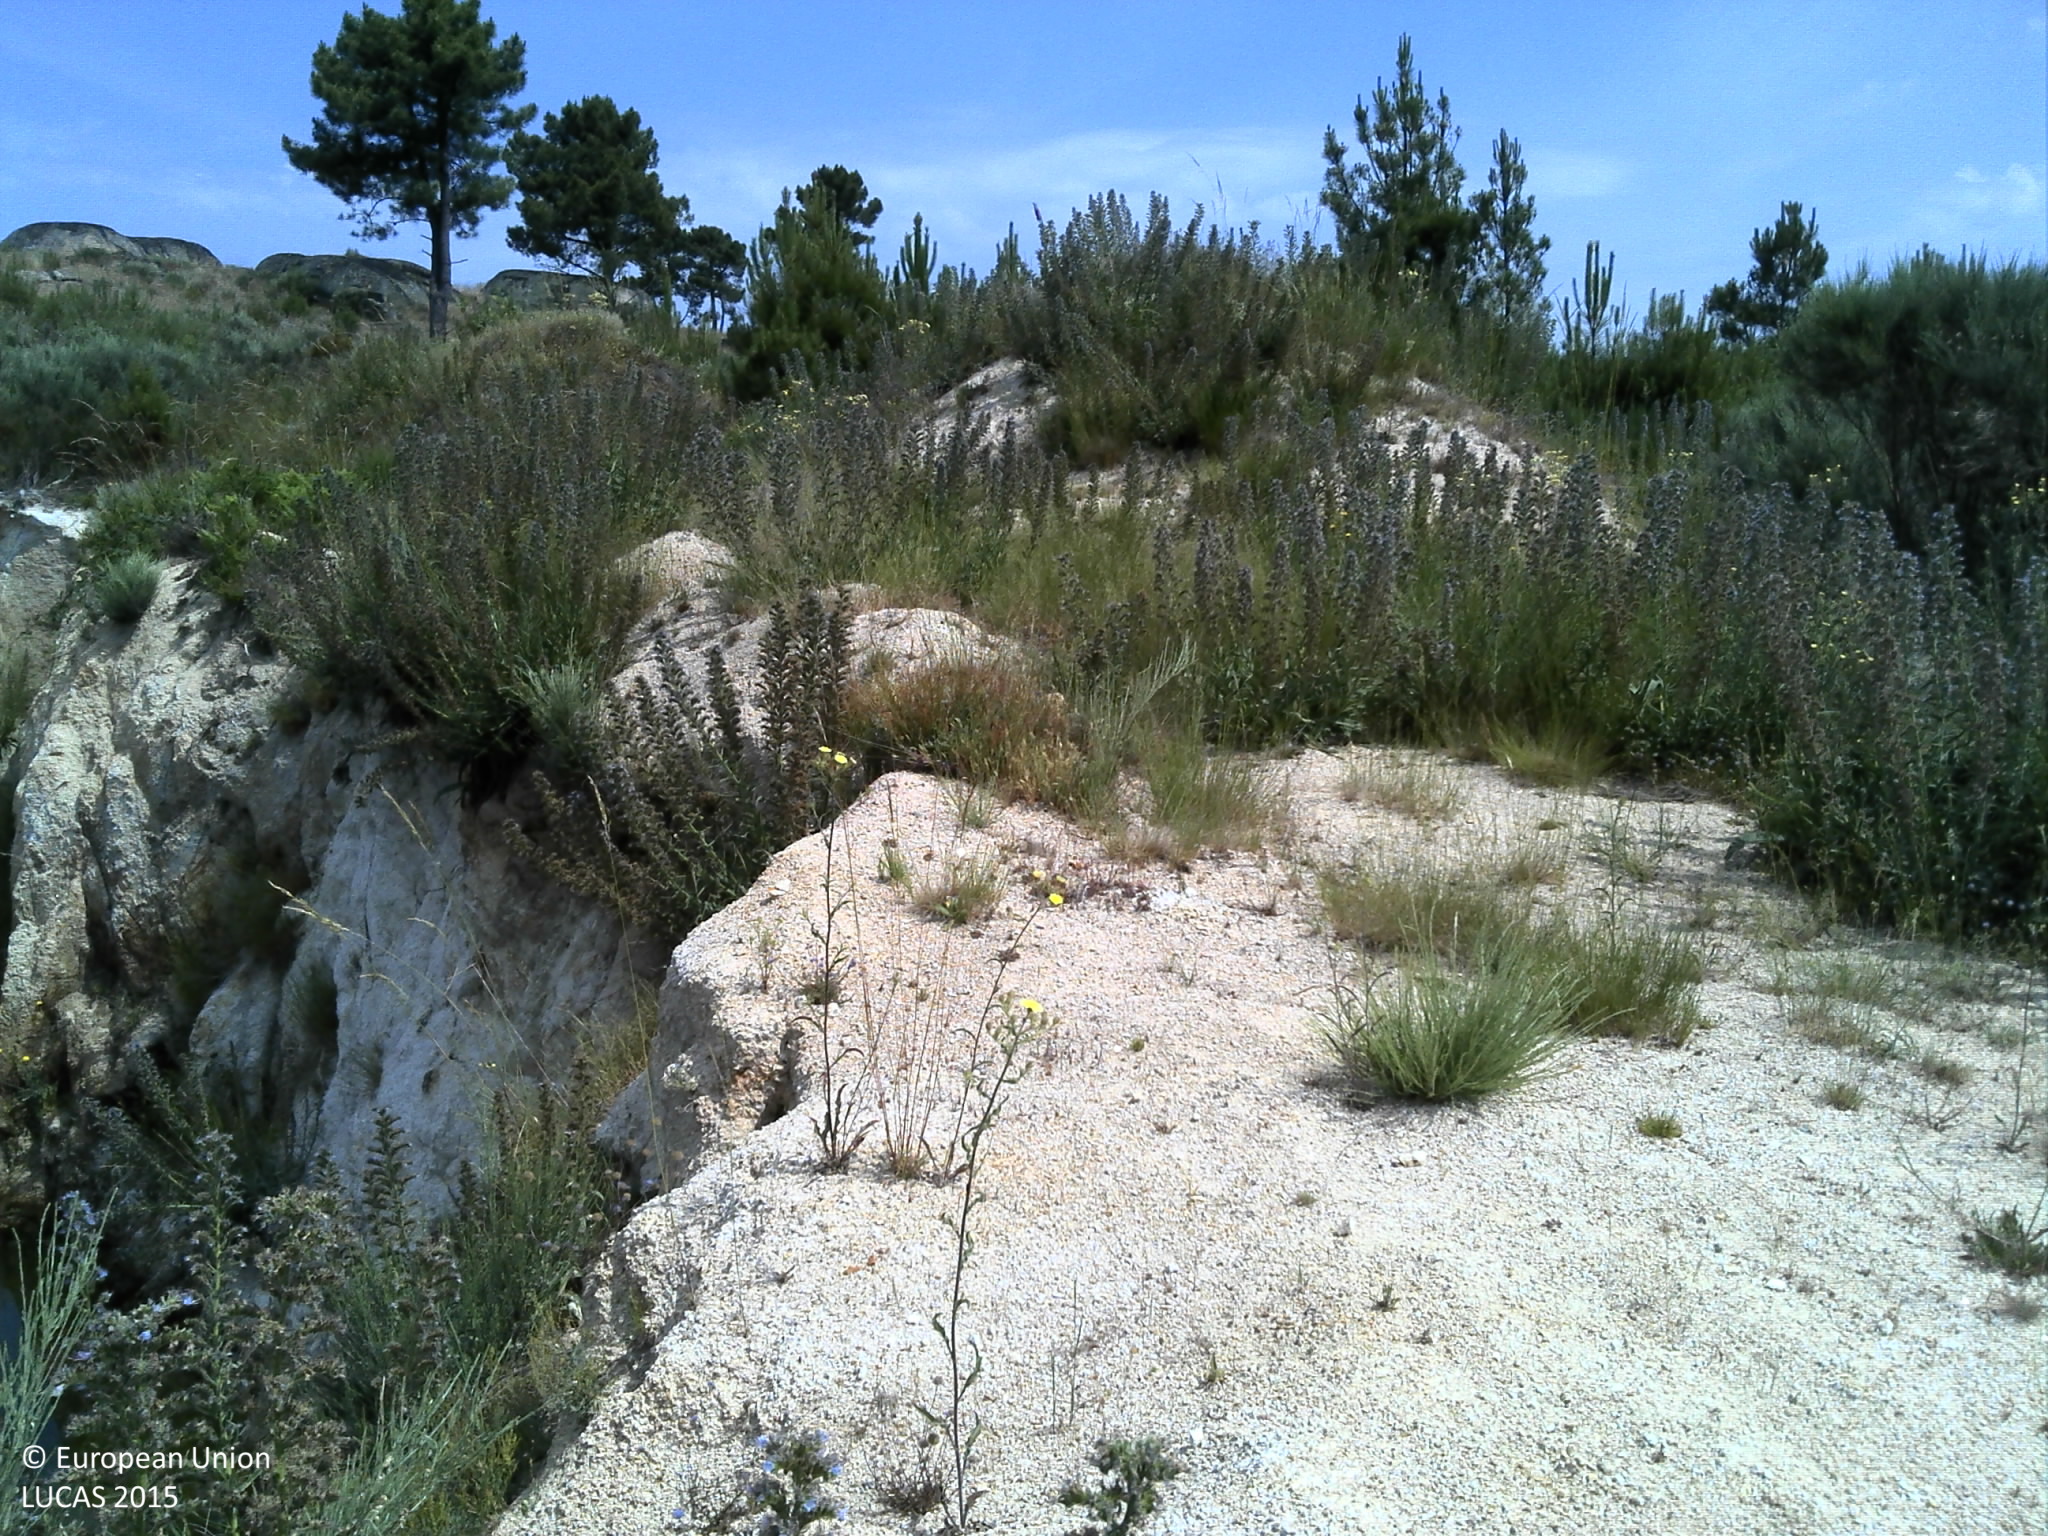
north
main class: Shrubland
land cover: Shrubland with sparse tree cover
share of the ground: 50 - 75 %
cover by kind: shrubs 70 %, unconsolidated bare surface 25 %, coniferous forest trees 5 %
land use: Semi-natural and natural areas not in use
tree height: > 5 m
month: June
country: PT
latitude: 41.4192
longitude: -7.5600
